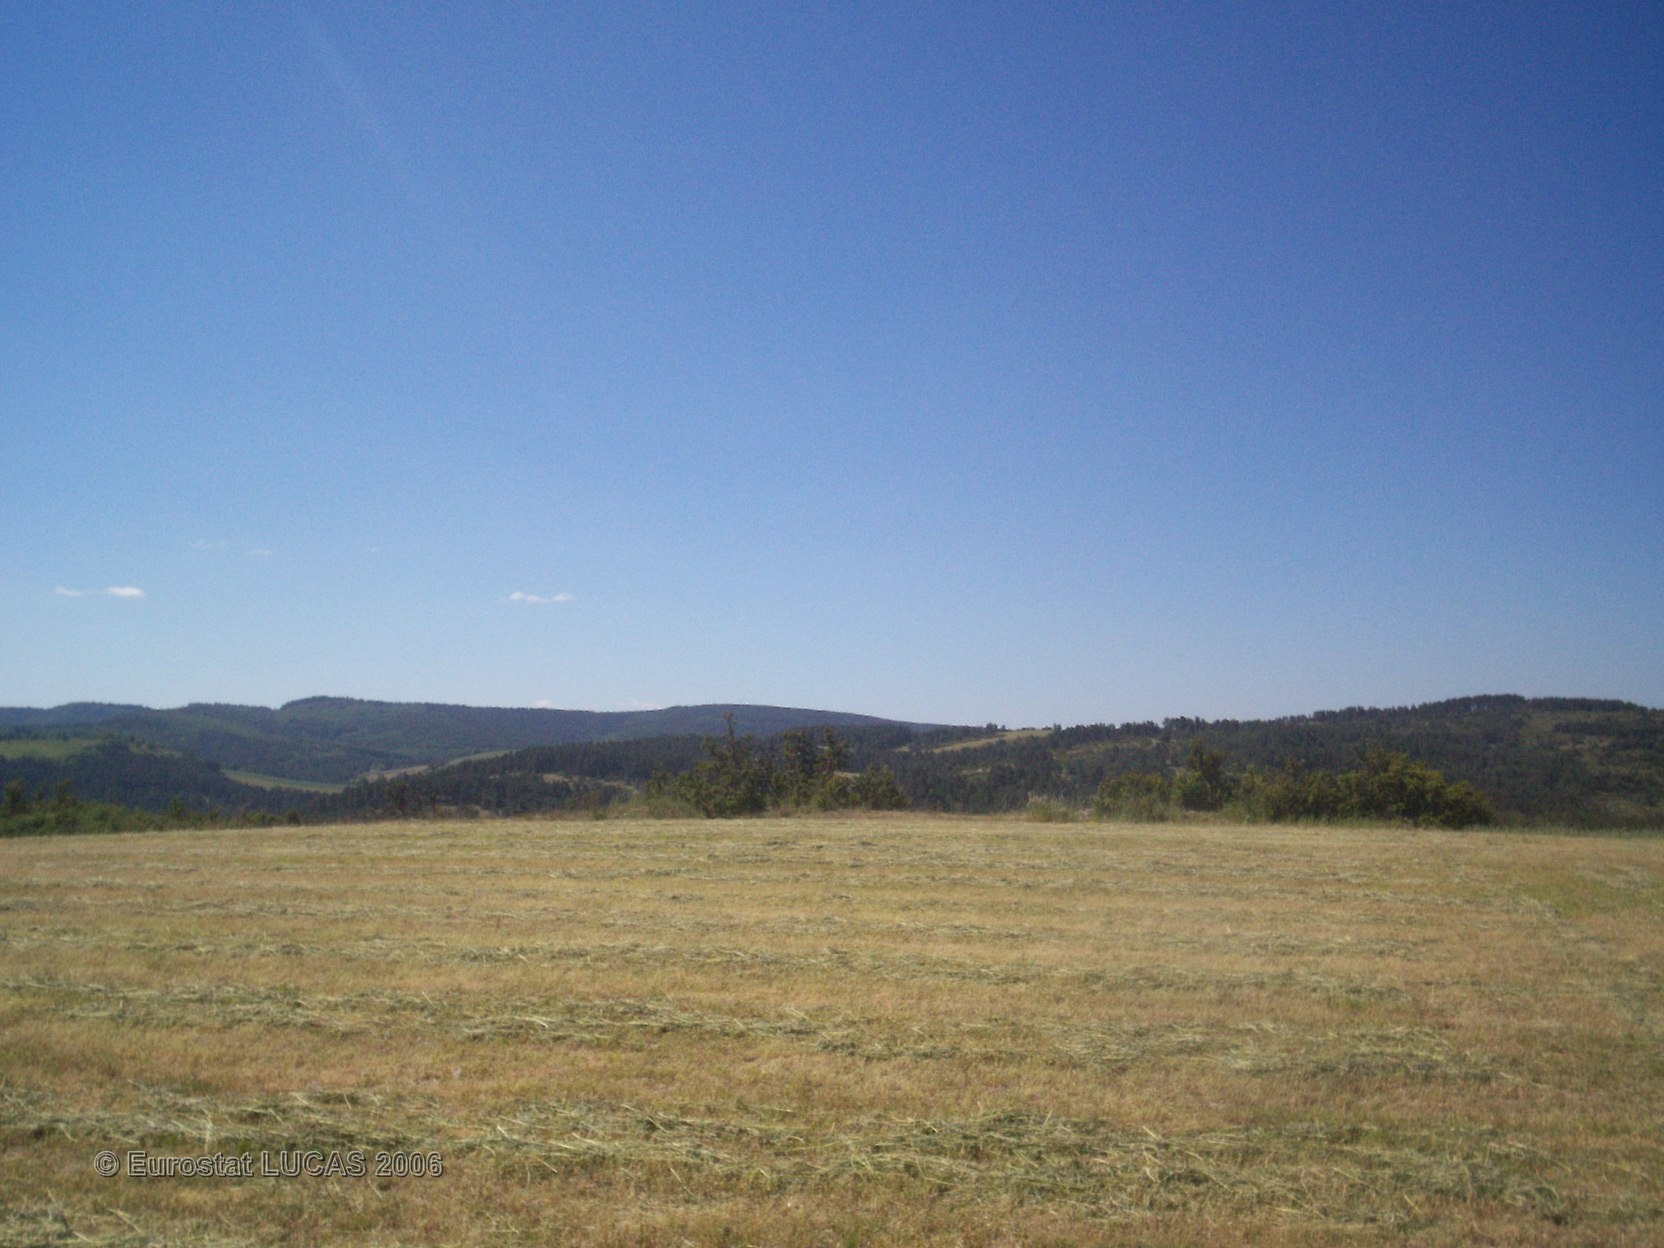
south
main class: Cropland
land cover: Other leguminous and mixtures for fodder
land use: Agriculture (excluding fallow land and kitchen gardens)
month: June
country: FR
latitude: 44.1775
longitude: 3.4145
